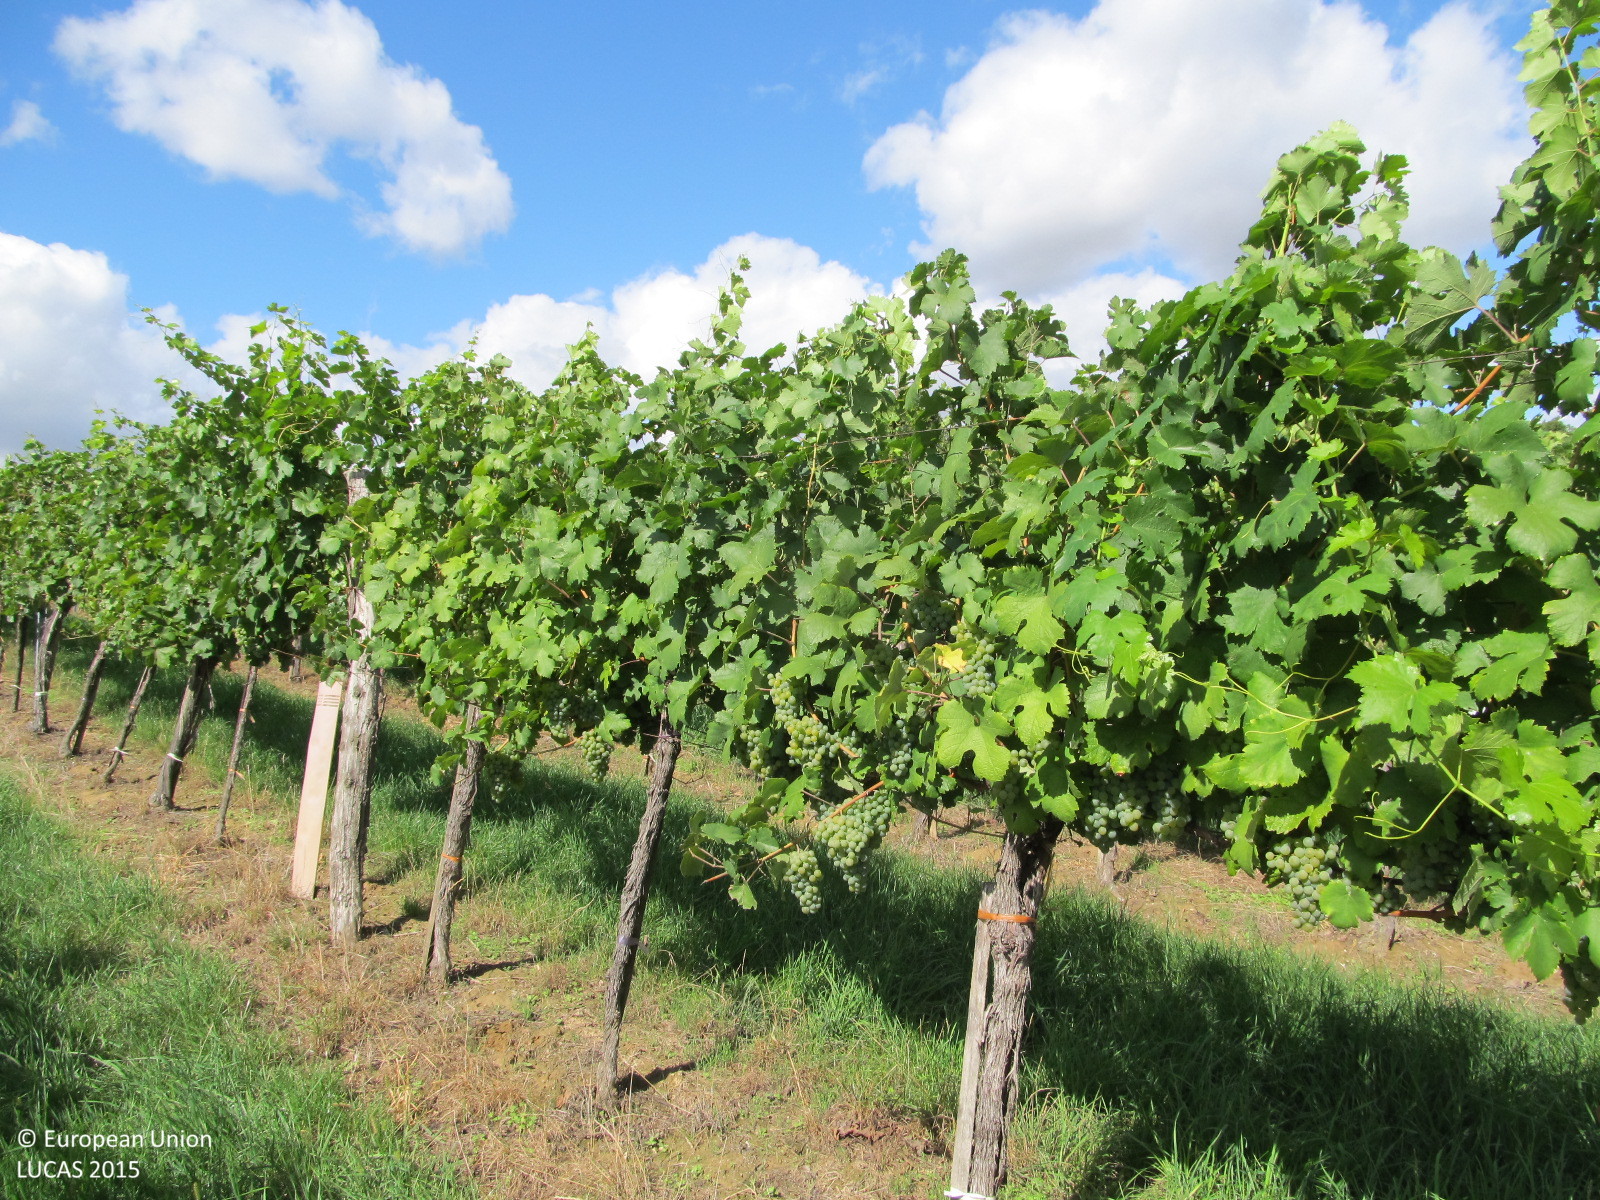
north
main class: Cropland
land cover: Vineyards
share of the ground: 25 - 50 %
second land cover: Grassland without tree/shrub cover
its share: 50 - 75 %
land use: Agriculture (excluding fallow land and kitchen gardens)
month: September
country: AT
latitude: 48.5004
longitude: 15.8640
